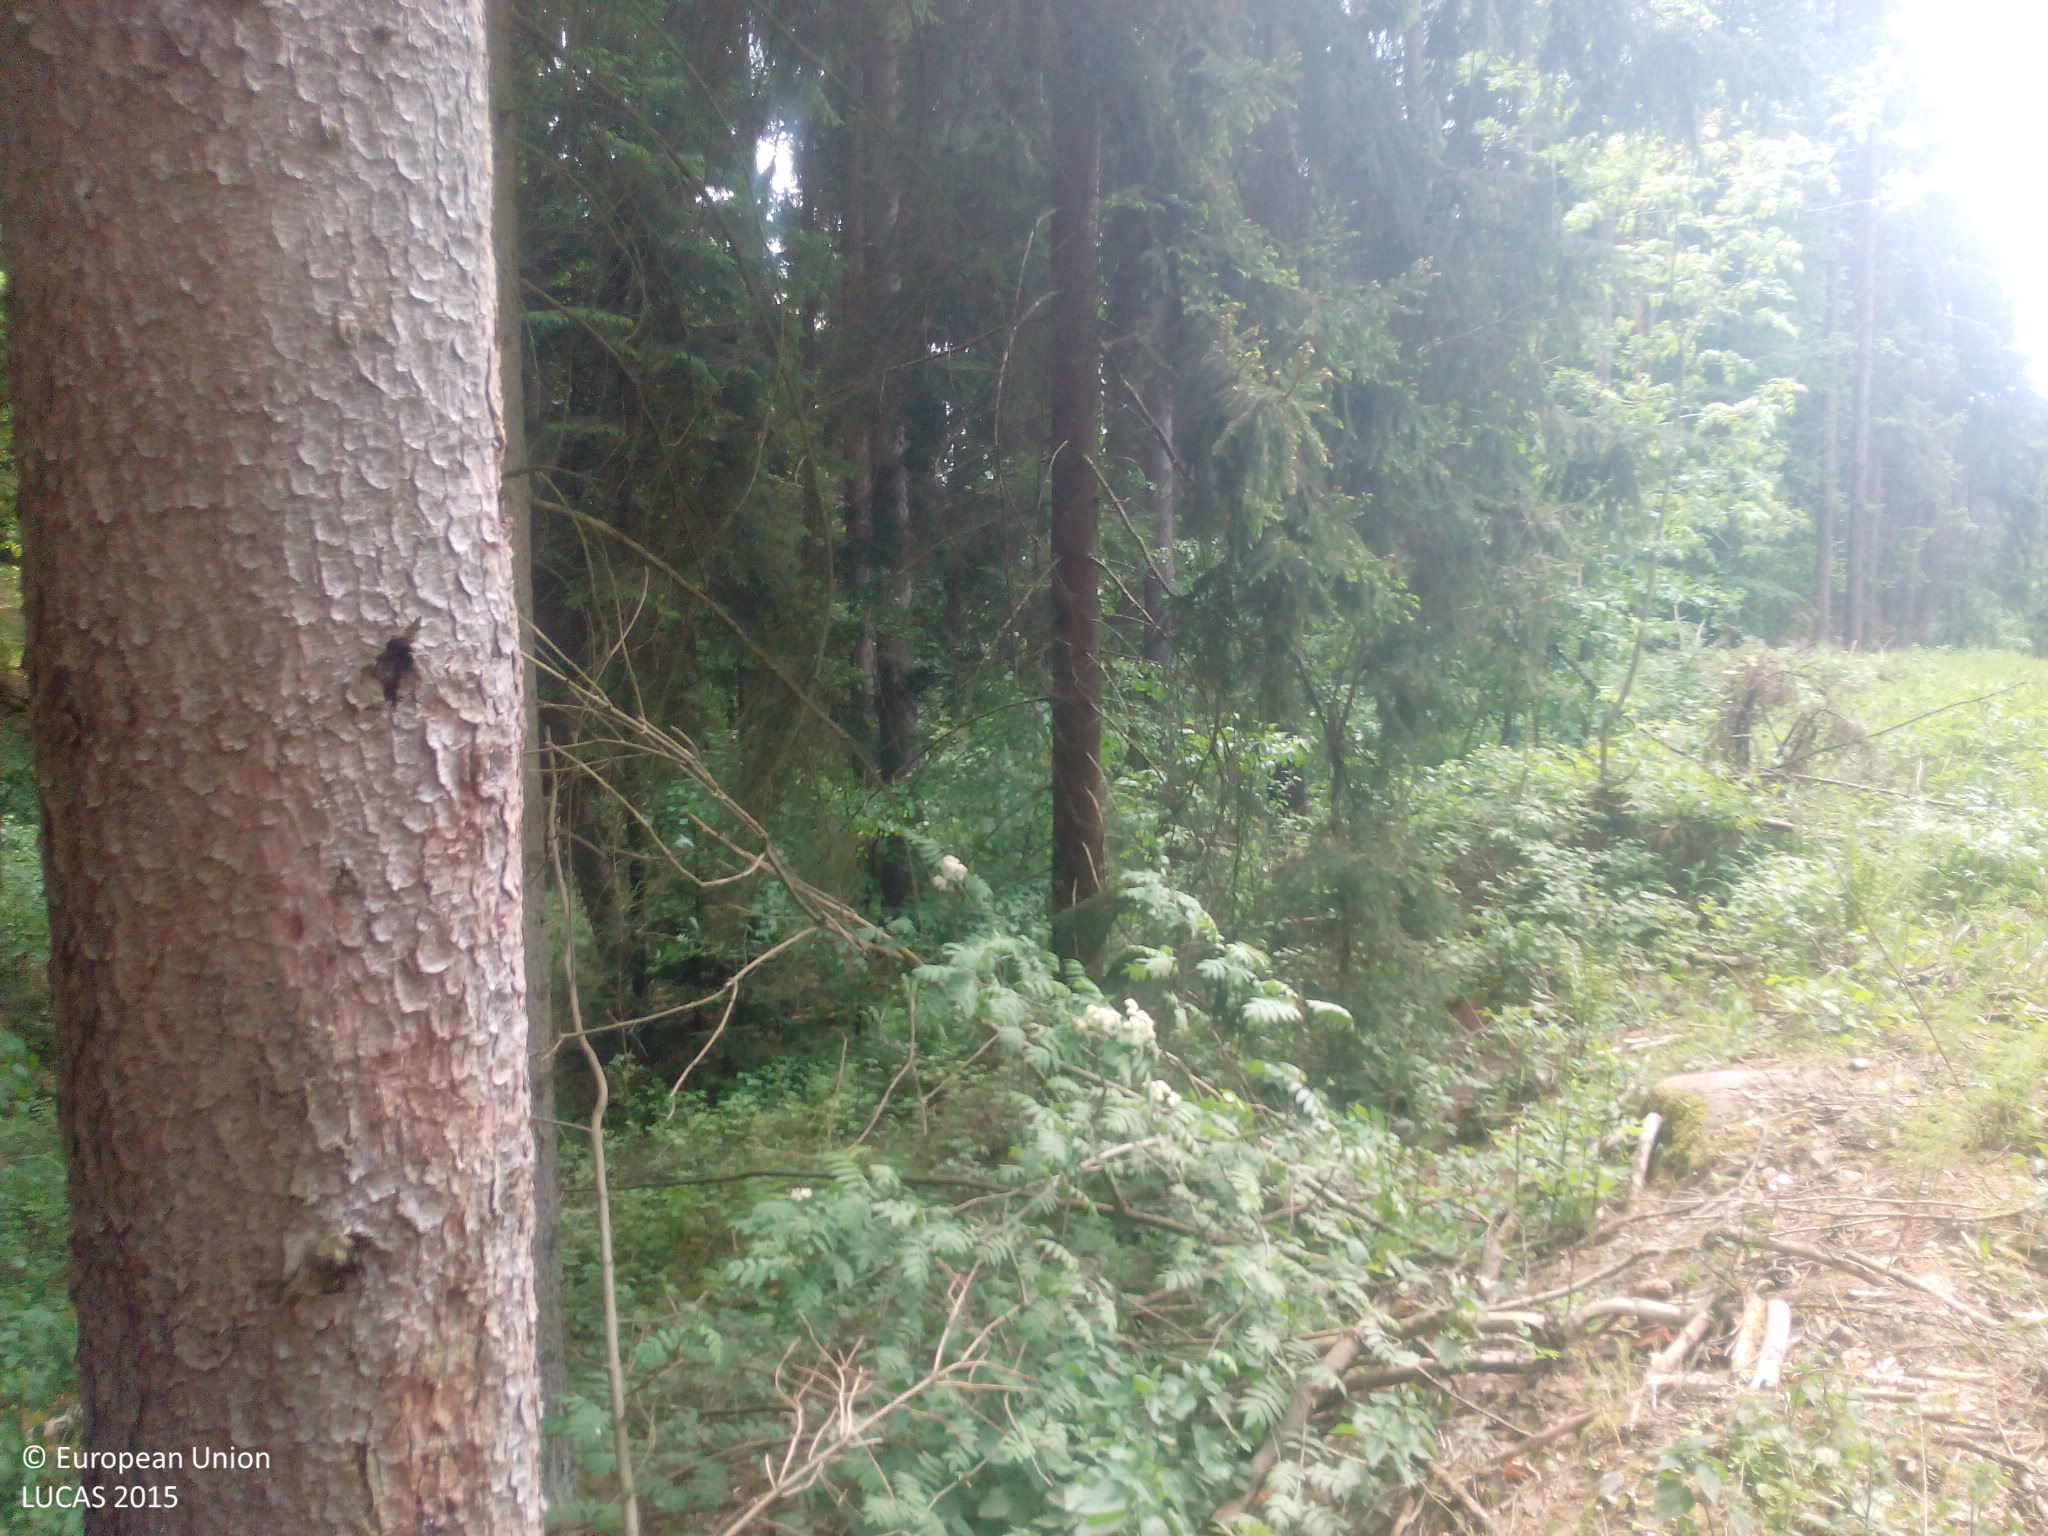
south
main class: Woodland
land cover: Spruce dominated mixed woodland
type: hemiboreal forest and nemoral coniferous forest and mixed broadleaved-coniferous forest
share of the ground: > 75 %
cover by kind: broadleaved forest trees 70 %, coniferous forest trees 30 %
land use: Forestry
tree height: > 5 m
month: May
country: DE
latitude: 50.2163
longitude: 10.9387
